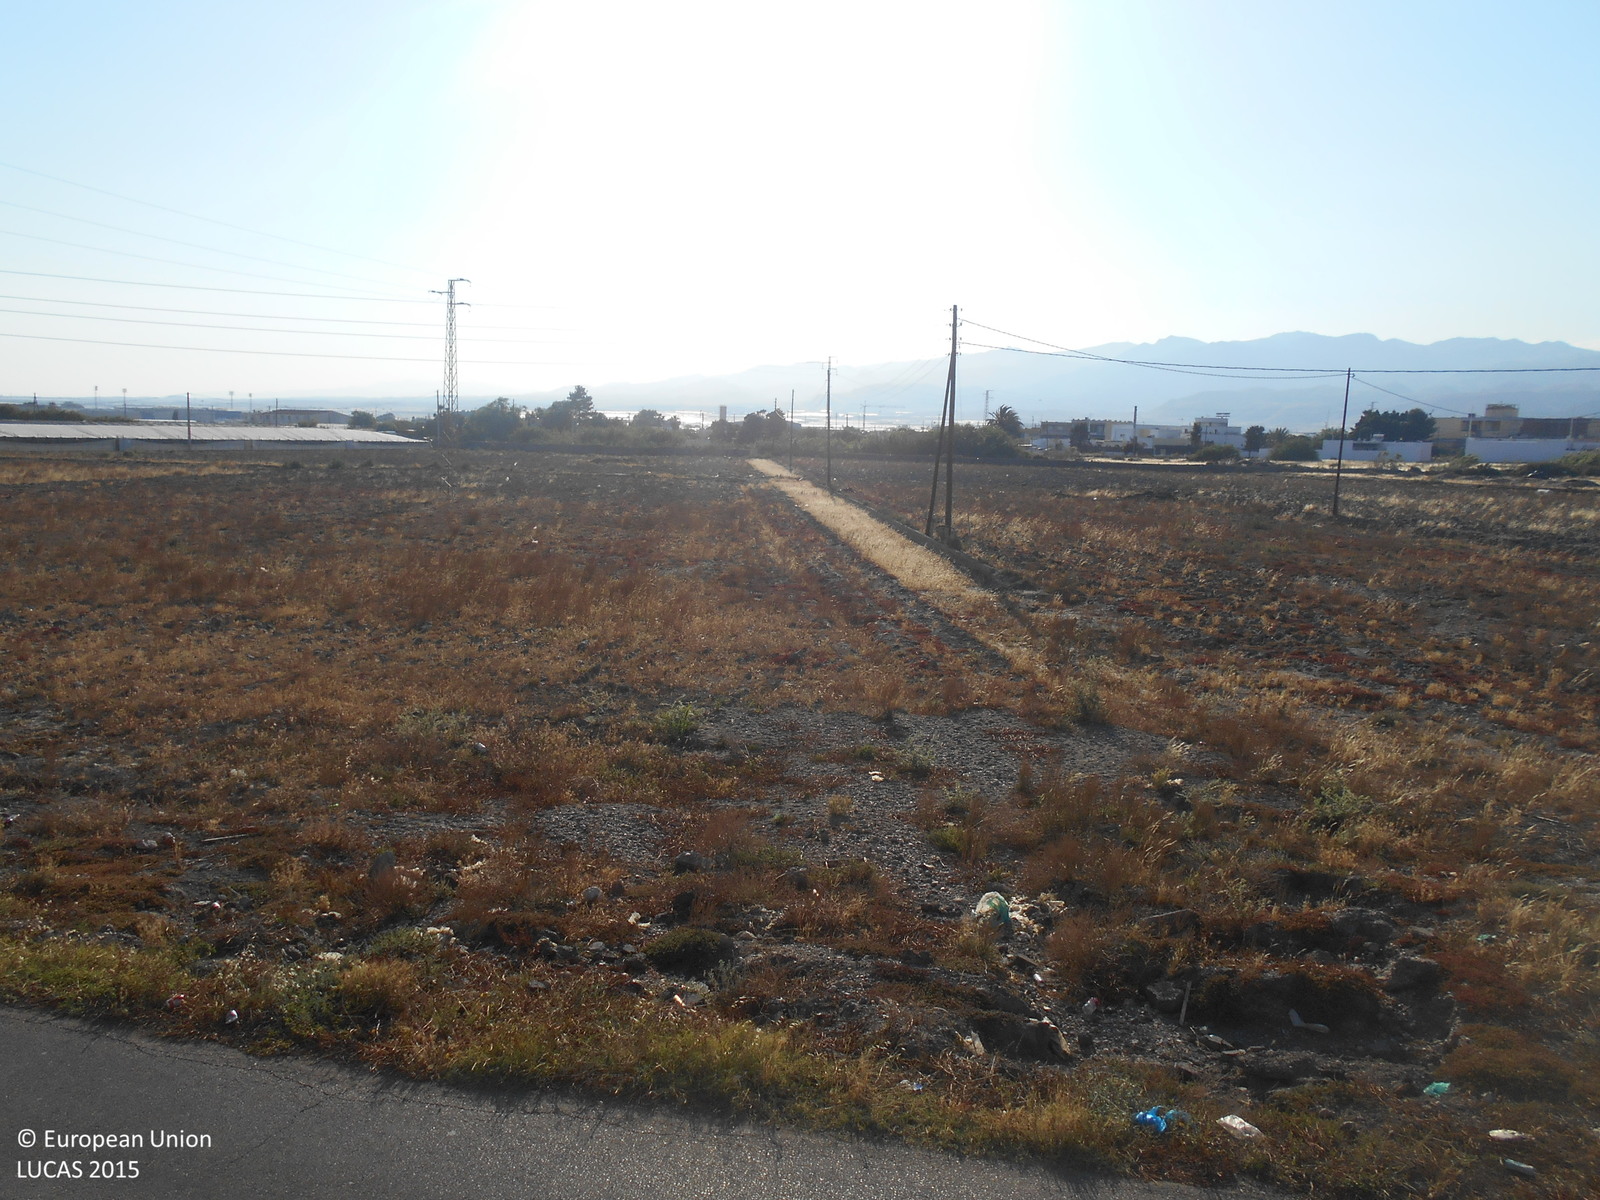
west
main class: Artificial land
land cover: Greenhouses
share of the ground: > 75 %
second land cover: Other fresh vegetables
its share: > 75 %
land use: Agriculture (excluding fallow land and kitchen gardens)
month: May
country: ES
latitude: 36.9309
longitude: -2.1333
